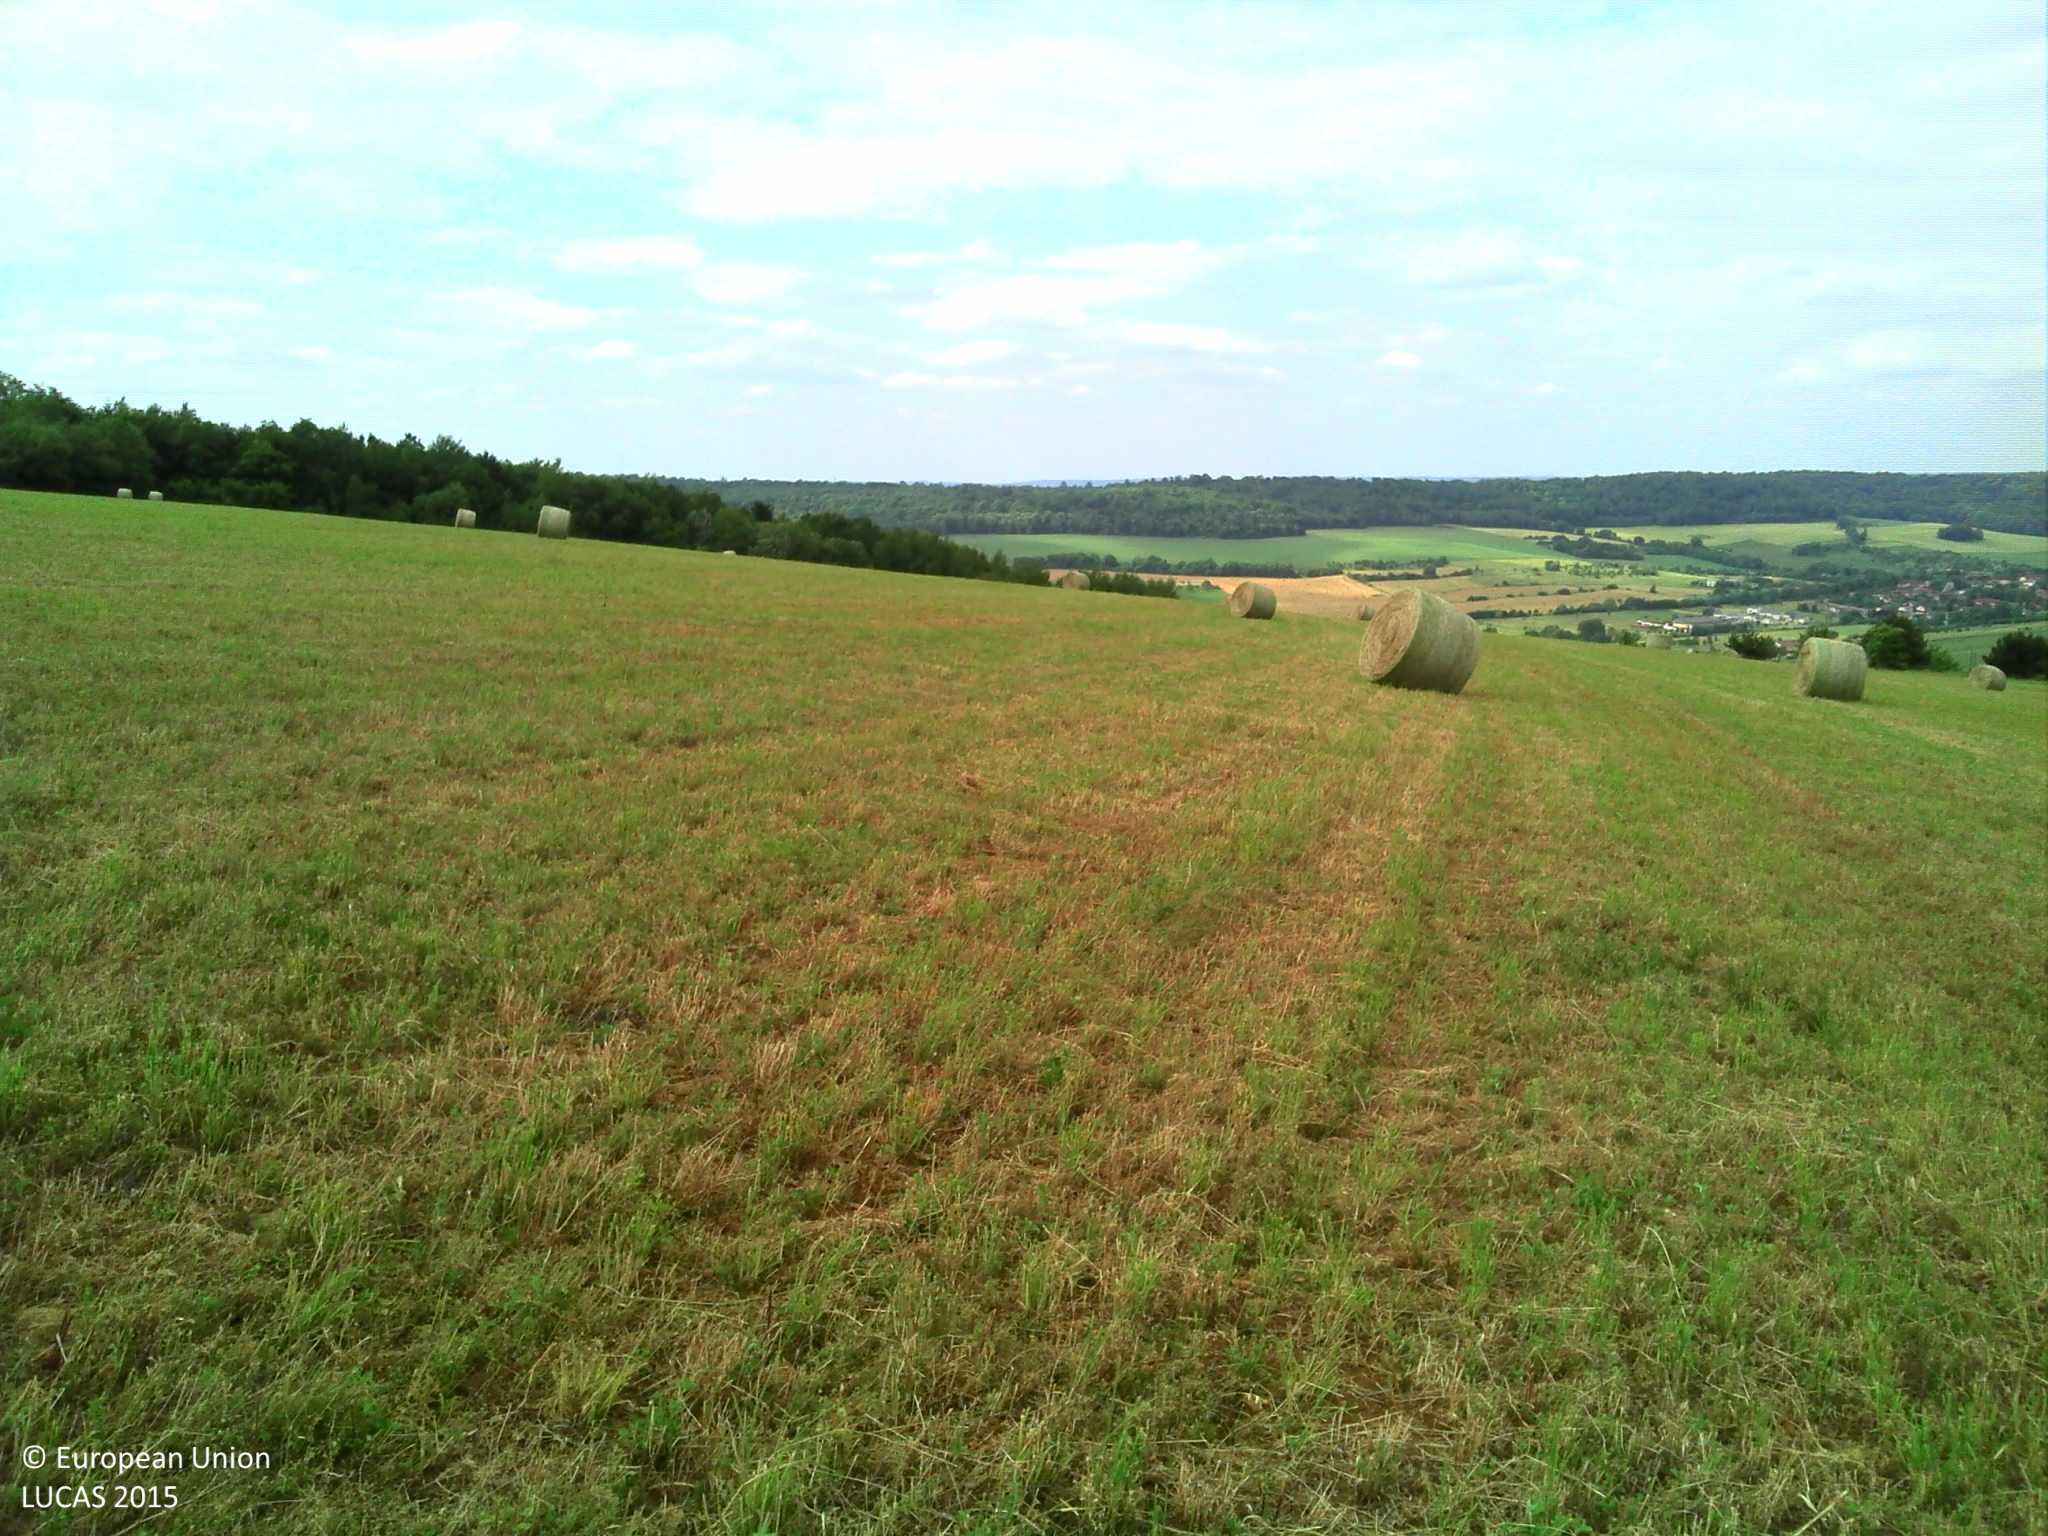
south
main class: Cropland
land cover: Temporary grasslands
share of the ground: > 75 %
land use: Agriculture (excluding fallow land and kitchen gardens)
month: June
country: FR
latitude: 48.8075
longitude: 6.2282
